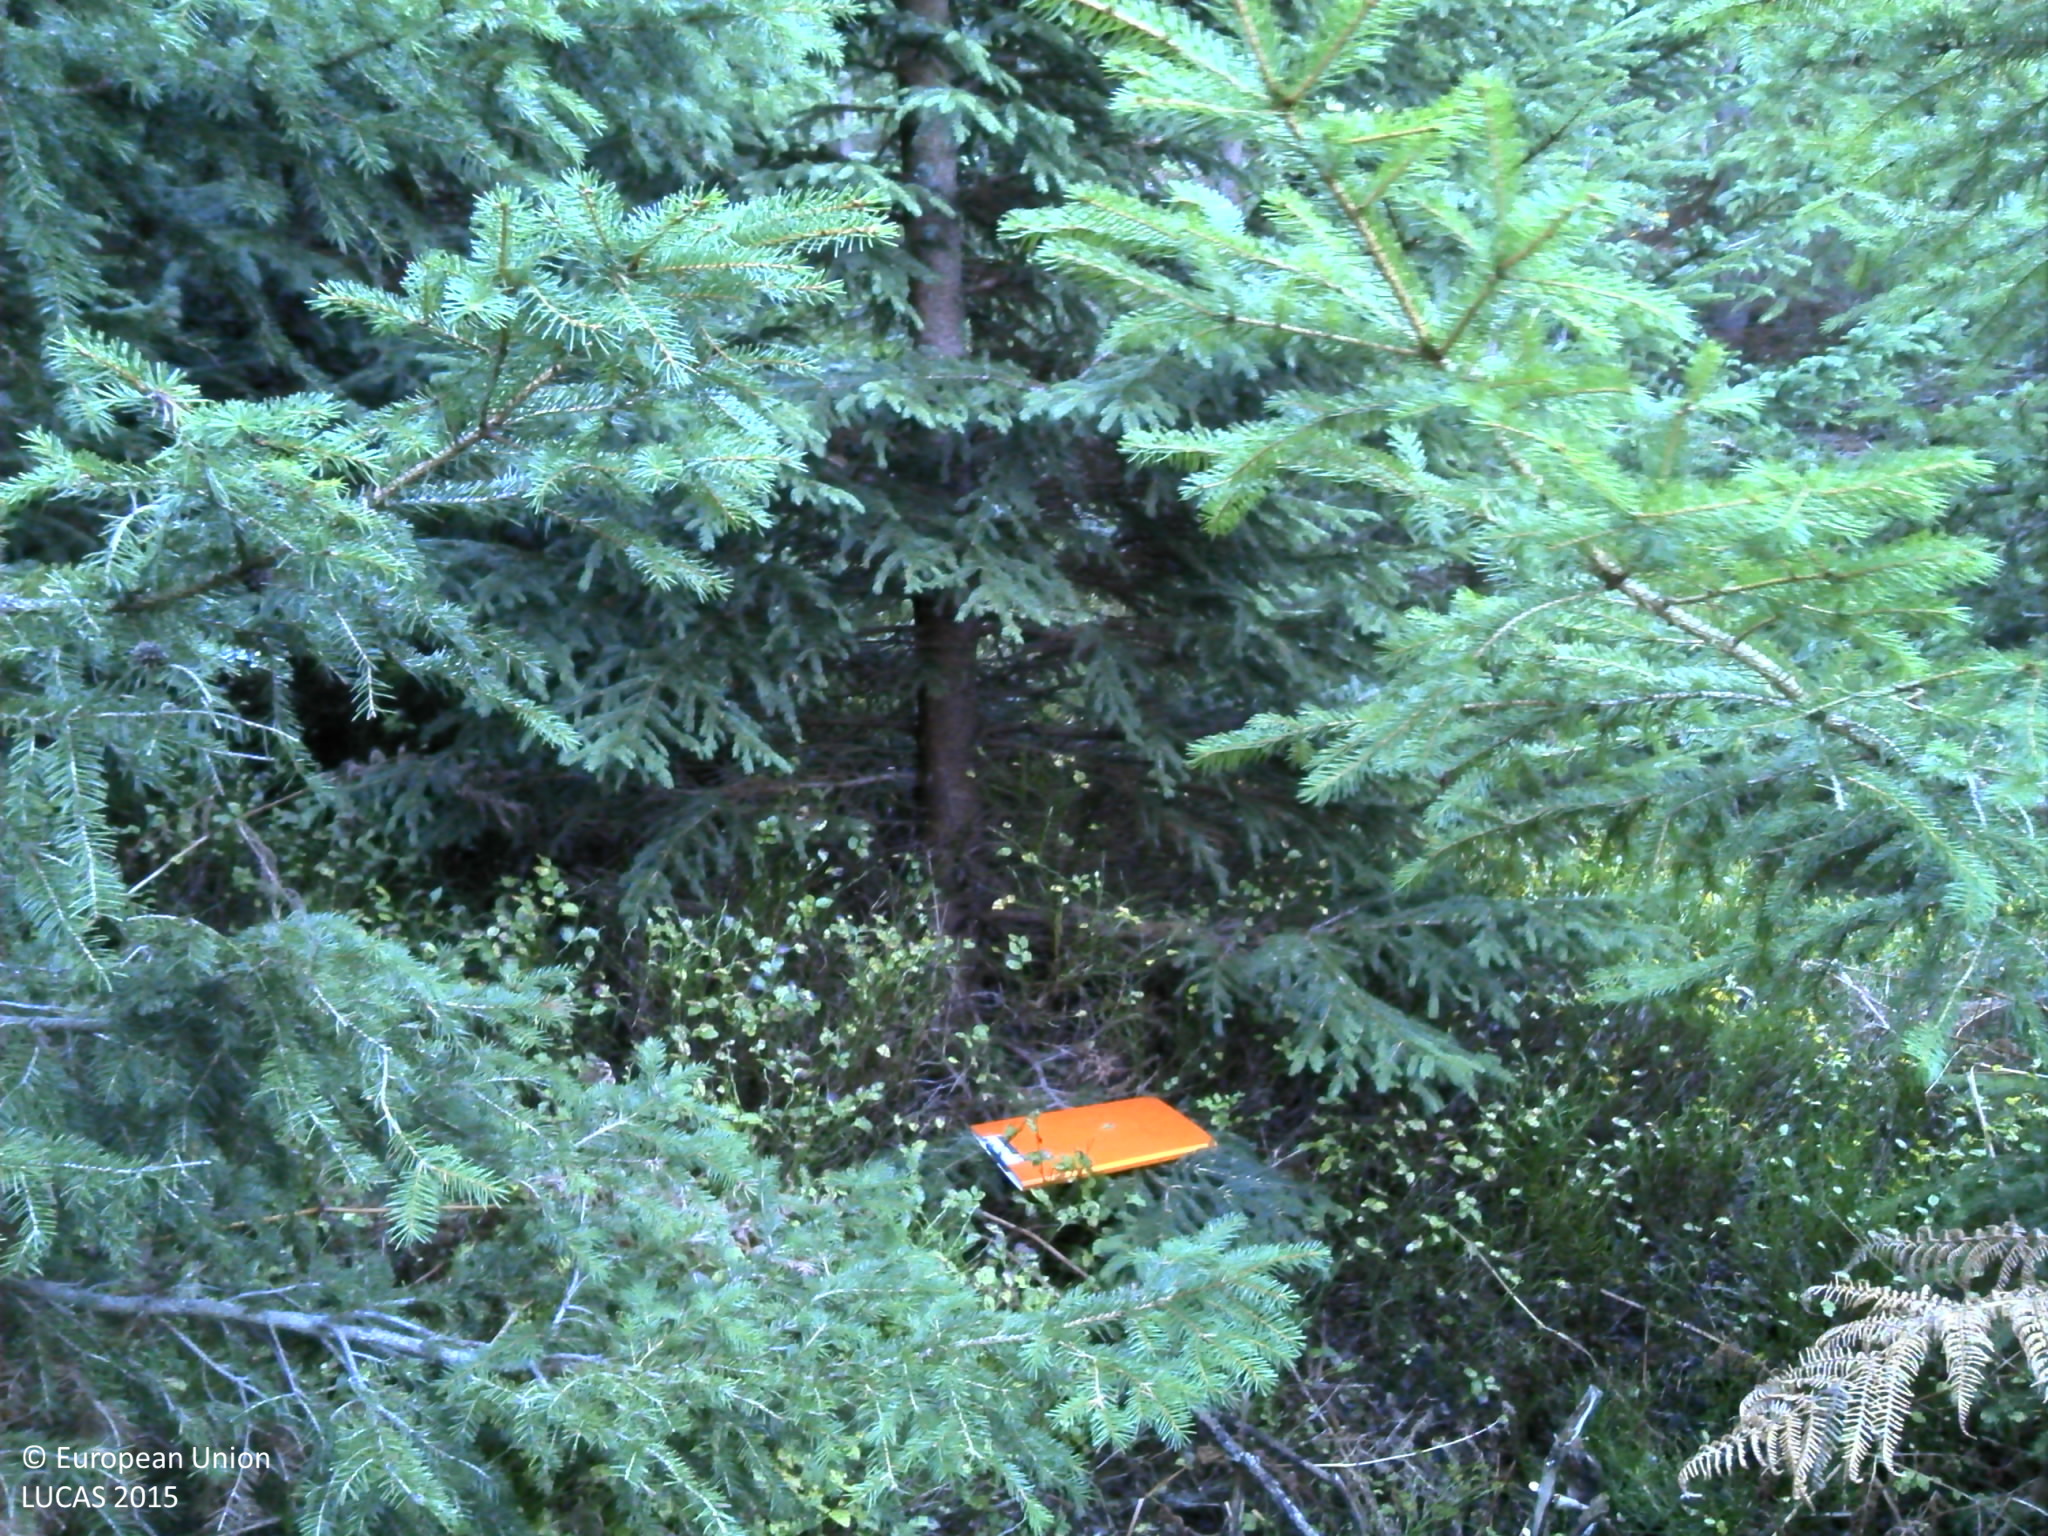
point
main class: Woodland
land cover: Spruce dominated coniferous woodland
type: exotic forest
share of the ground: > 75 %
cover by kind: coniferous forest trees 90 %, shrubs 5 %, herbaceous plants 5 %
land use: Forestry
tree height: > 5 m
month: October
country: FR
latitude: 45.6985
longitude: 3.7474
